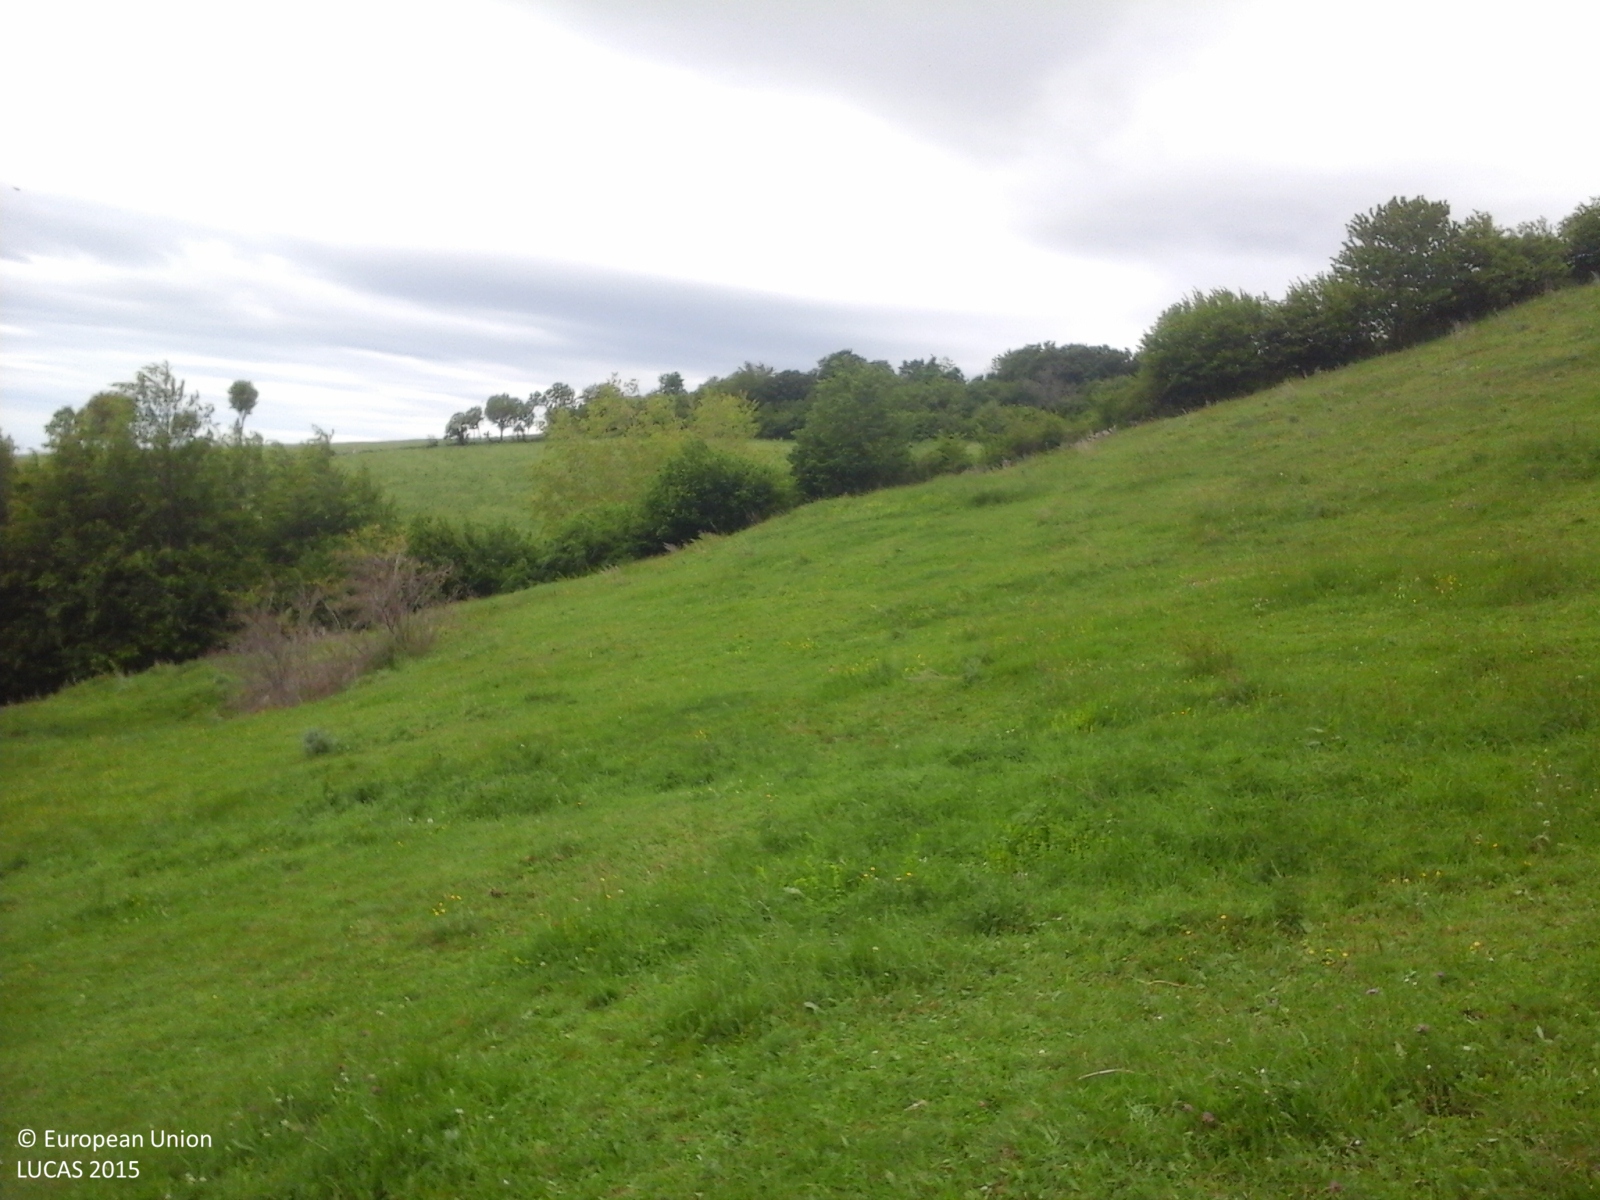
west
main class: Woodland
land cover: Broadleaved woodland
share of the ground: > 75 %
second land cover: Grassland without tree/shrub cover
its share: > 75 %
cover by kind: broadleaved forest trees 45 %, herbaceous plants 45 %, shrubs 10 %
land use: Forestry
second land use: Agriculture (excluding fallow land and kitchen gardens)
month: May
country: IT
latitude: 45.6622
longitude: 10.9610
